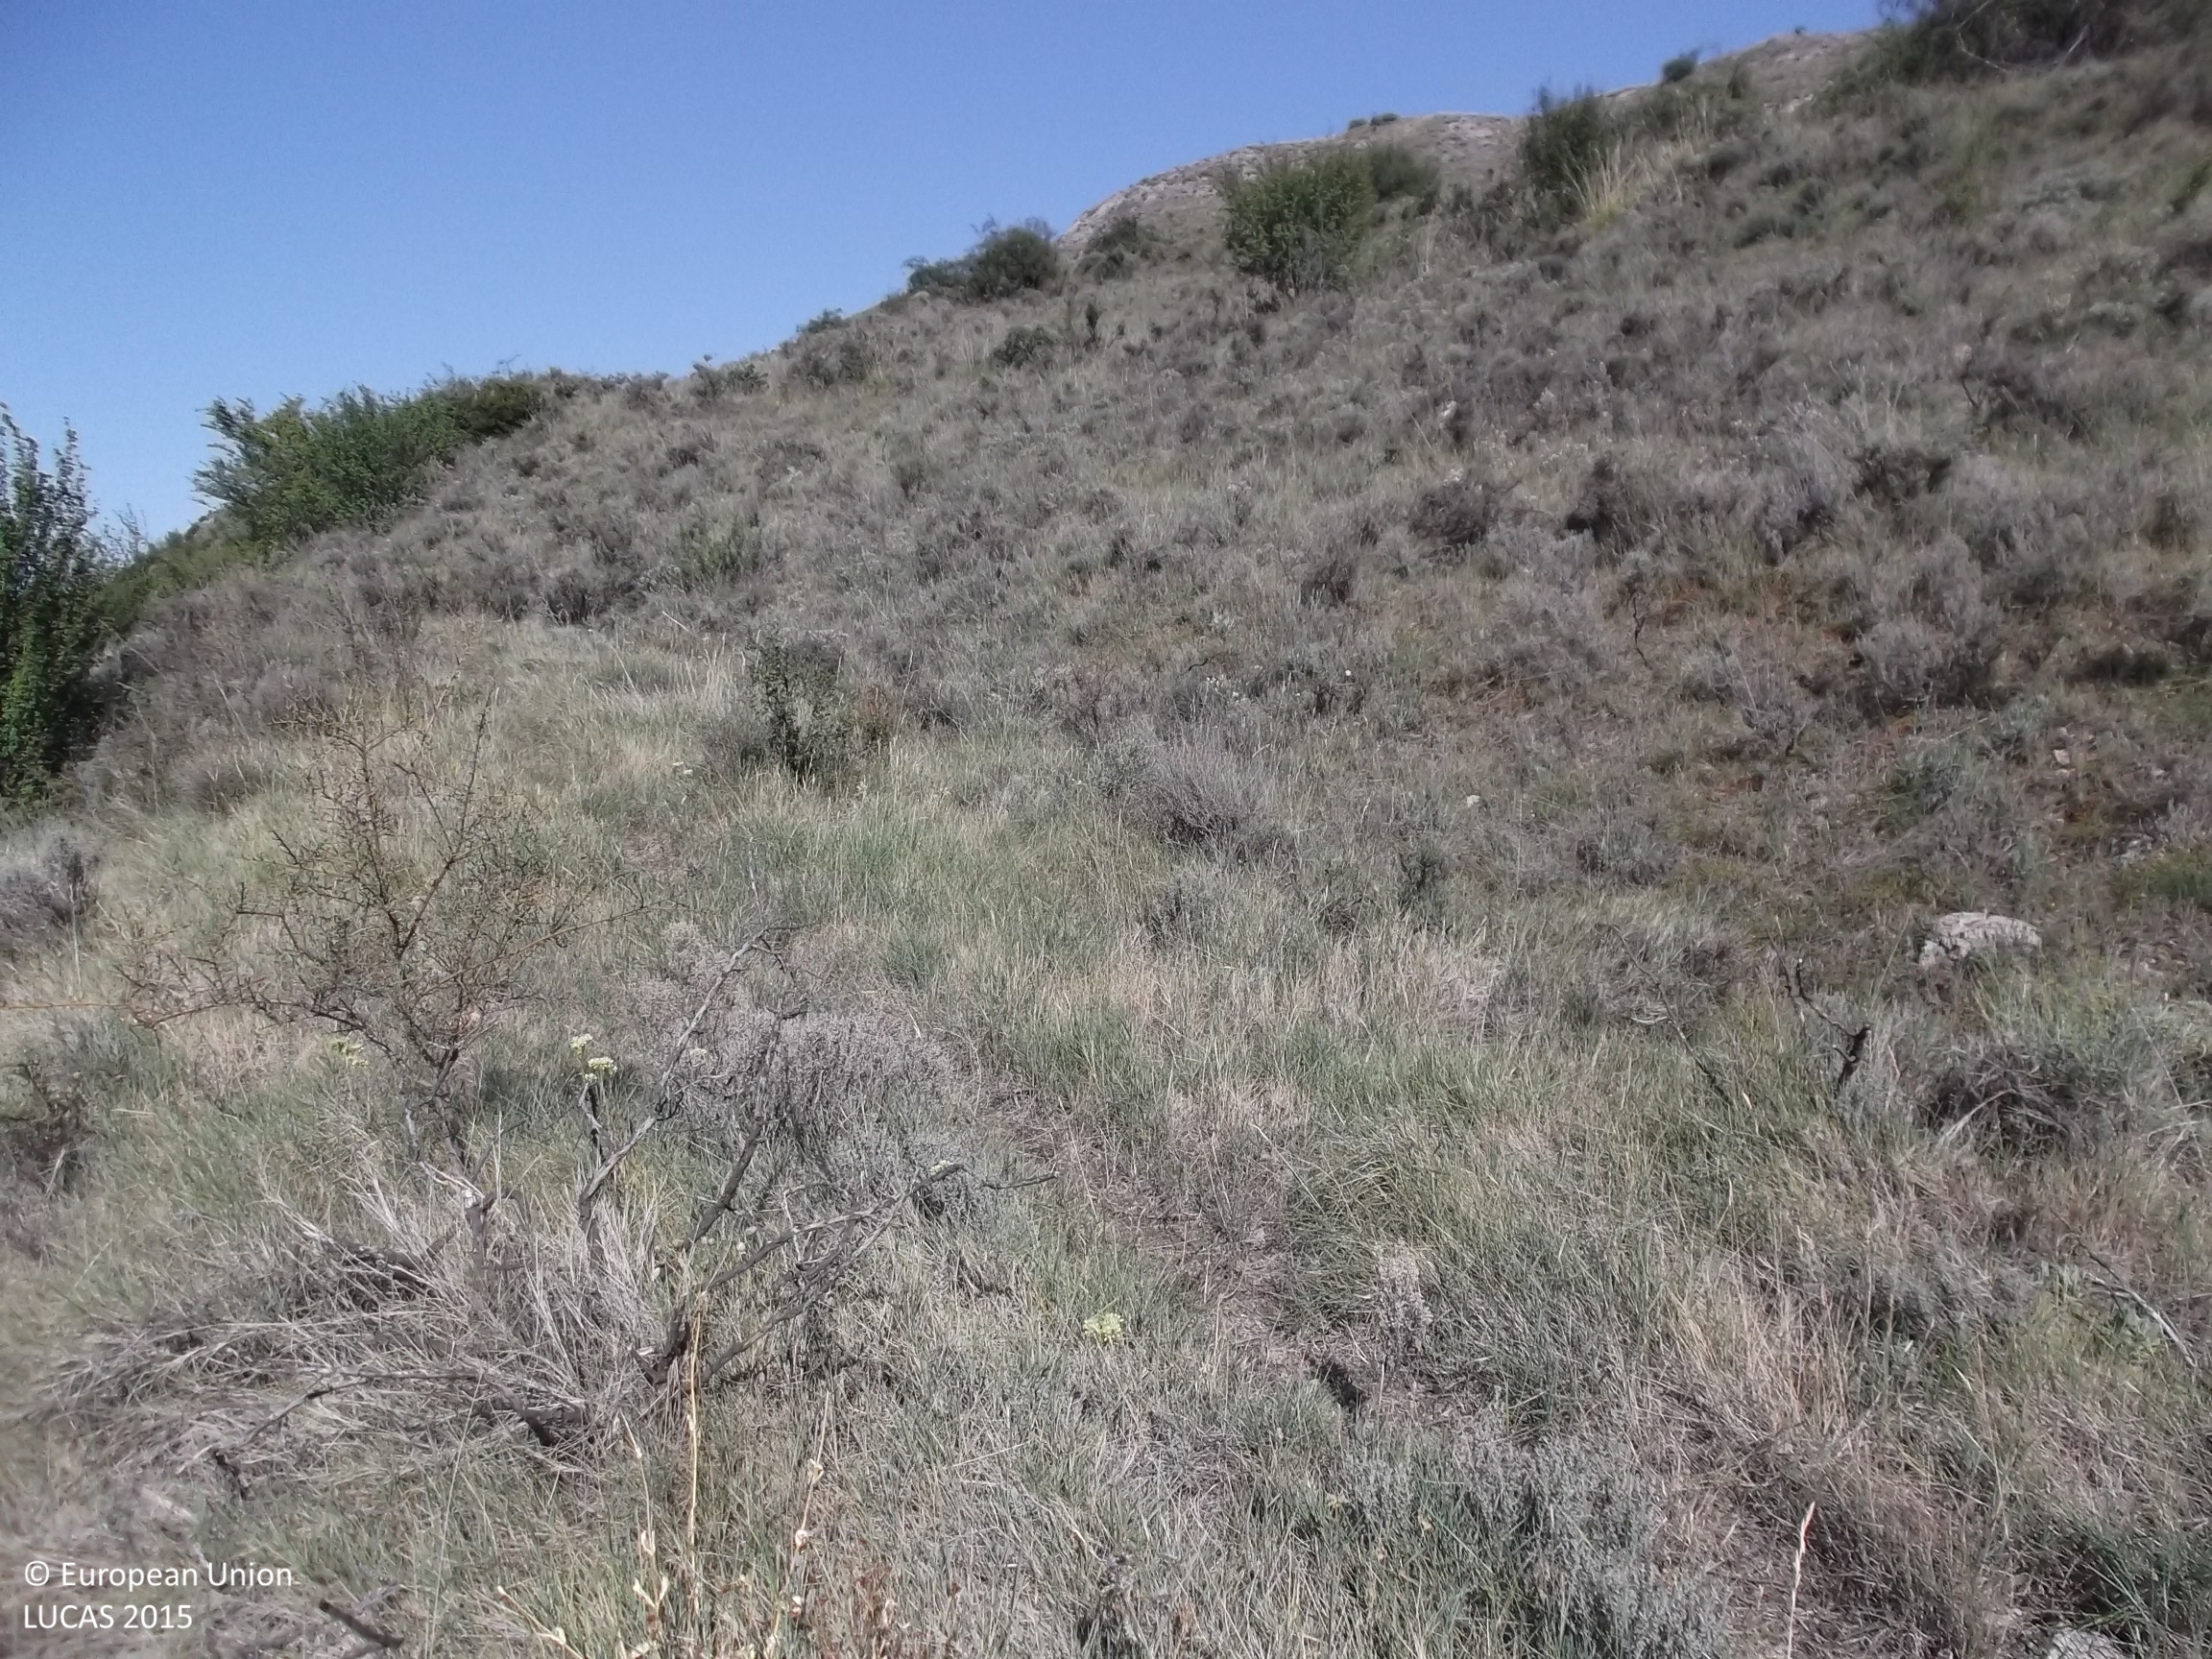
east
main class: Shrubland
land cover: Shrubland with sparse tree cover
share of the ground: 50 - 75 %
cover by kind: shrubs 50 %, herbaceous plants 30 %, unconsolidated bare surface 10 %, broadleaved forest trees 5 %, lichens and mosses 5 %
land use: Semi-natural and natural areas not in use
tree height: < 5 m
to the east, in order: Shrubland with sparse tree cover; Shrubland without tree cover
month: August
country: ES
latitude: 42.3436
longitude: -2.4121
